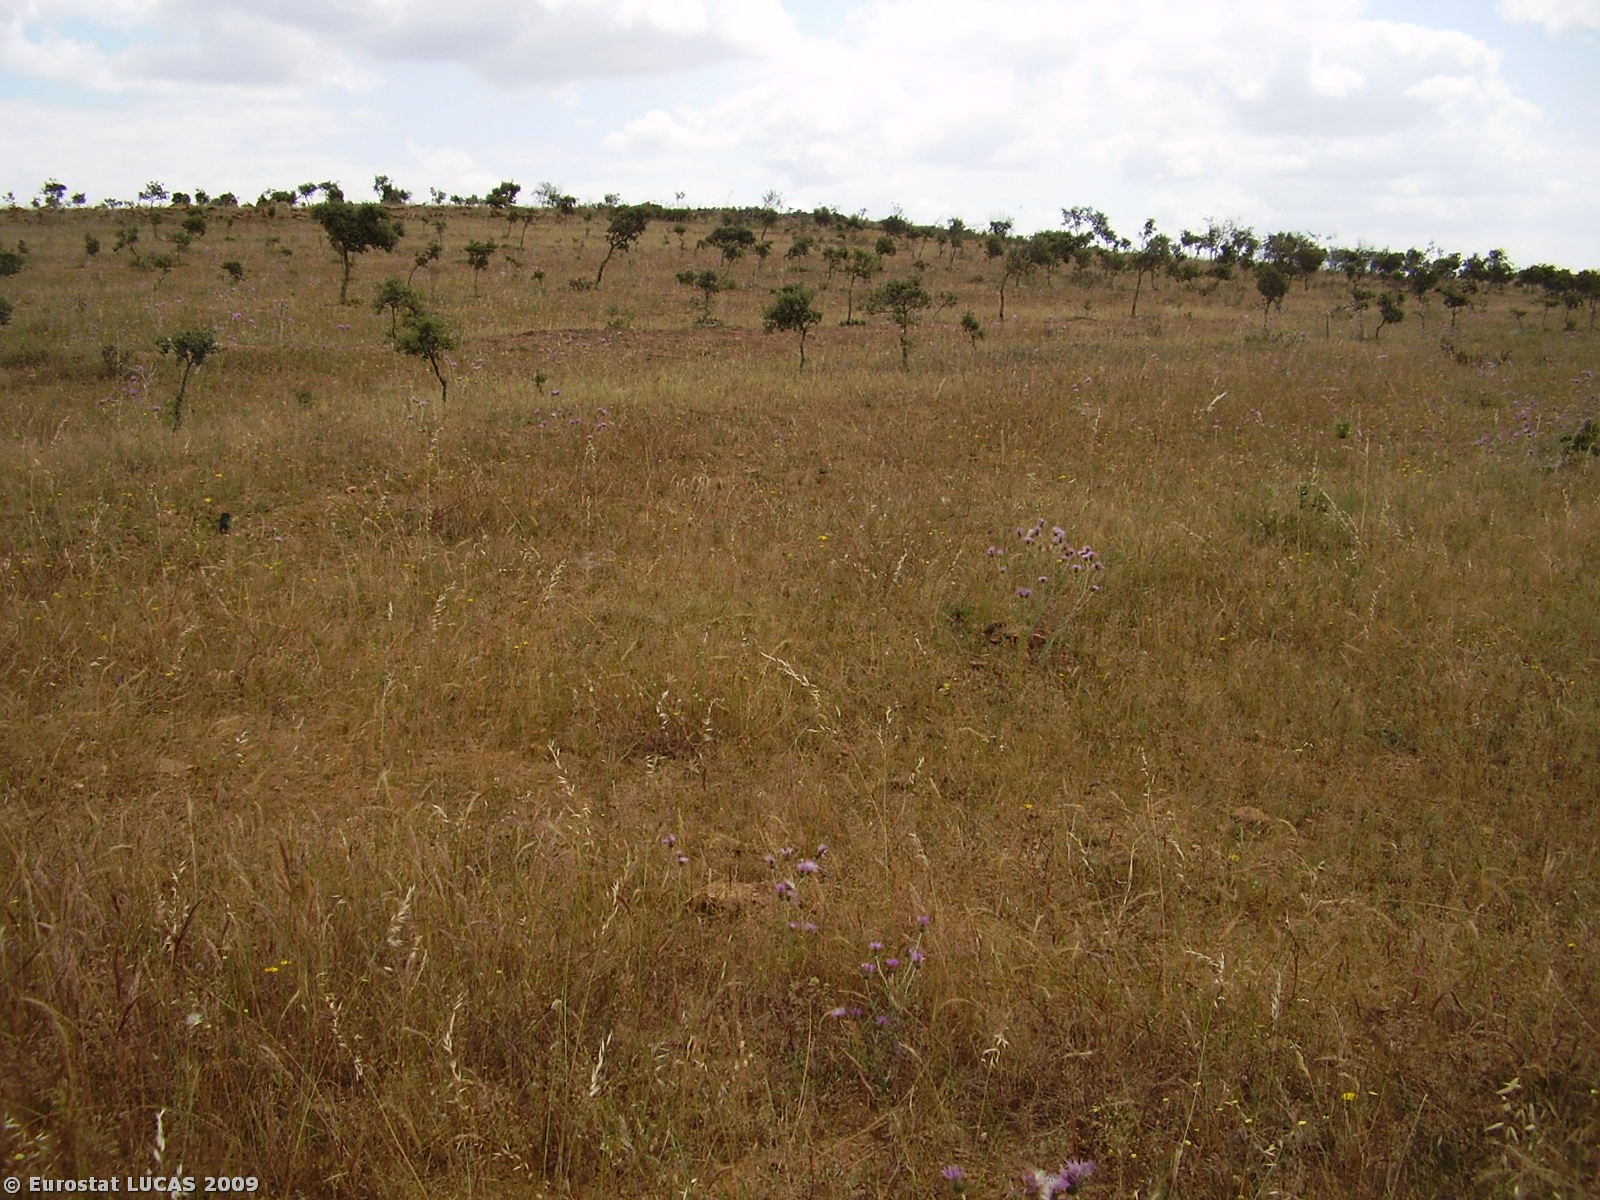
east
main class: Woodland
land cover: Broadleaved woodland
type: broadleaved evergreen forest
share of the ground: 25 - 50 %
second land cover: Spontaneously vegetated surfaces
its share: > 75 %
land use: Forestry
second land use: Fallow land
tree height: > 5 m
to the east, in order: Broadleaved woodland; Spontaneously vegetated surfaces; Broadleaved woodland
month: May
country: PT
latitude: 37.7948
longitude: -7.8874
